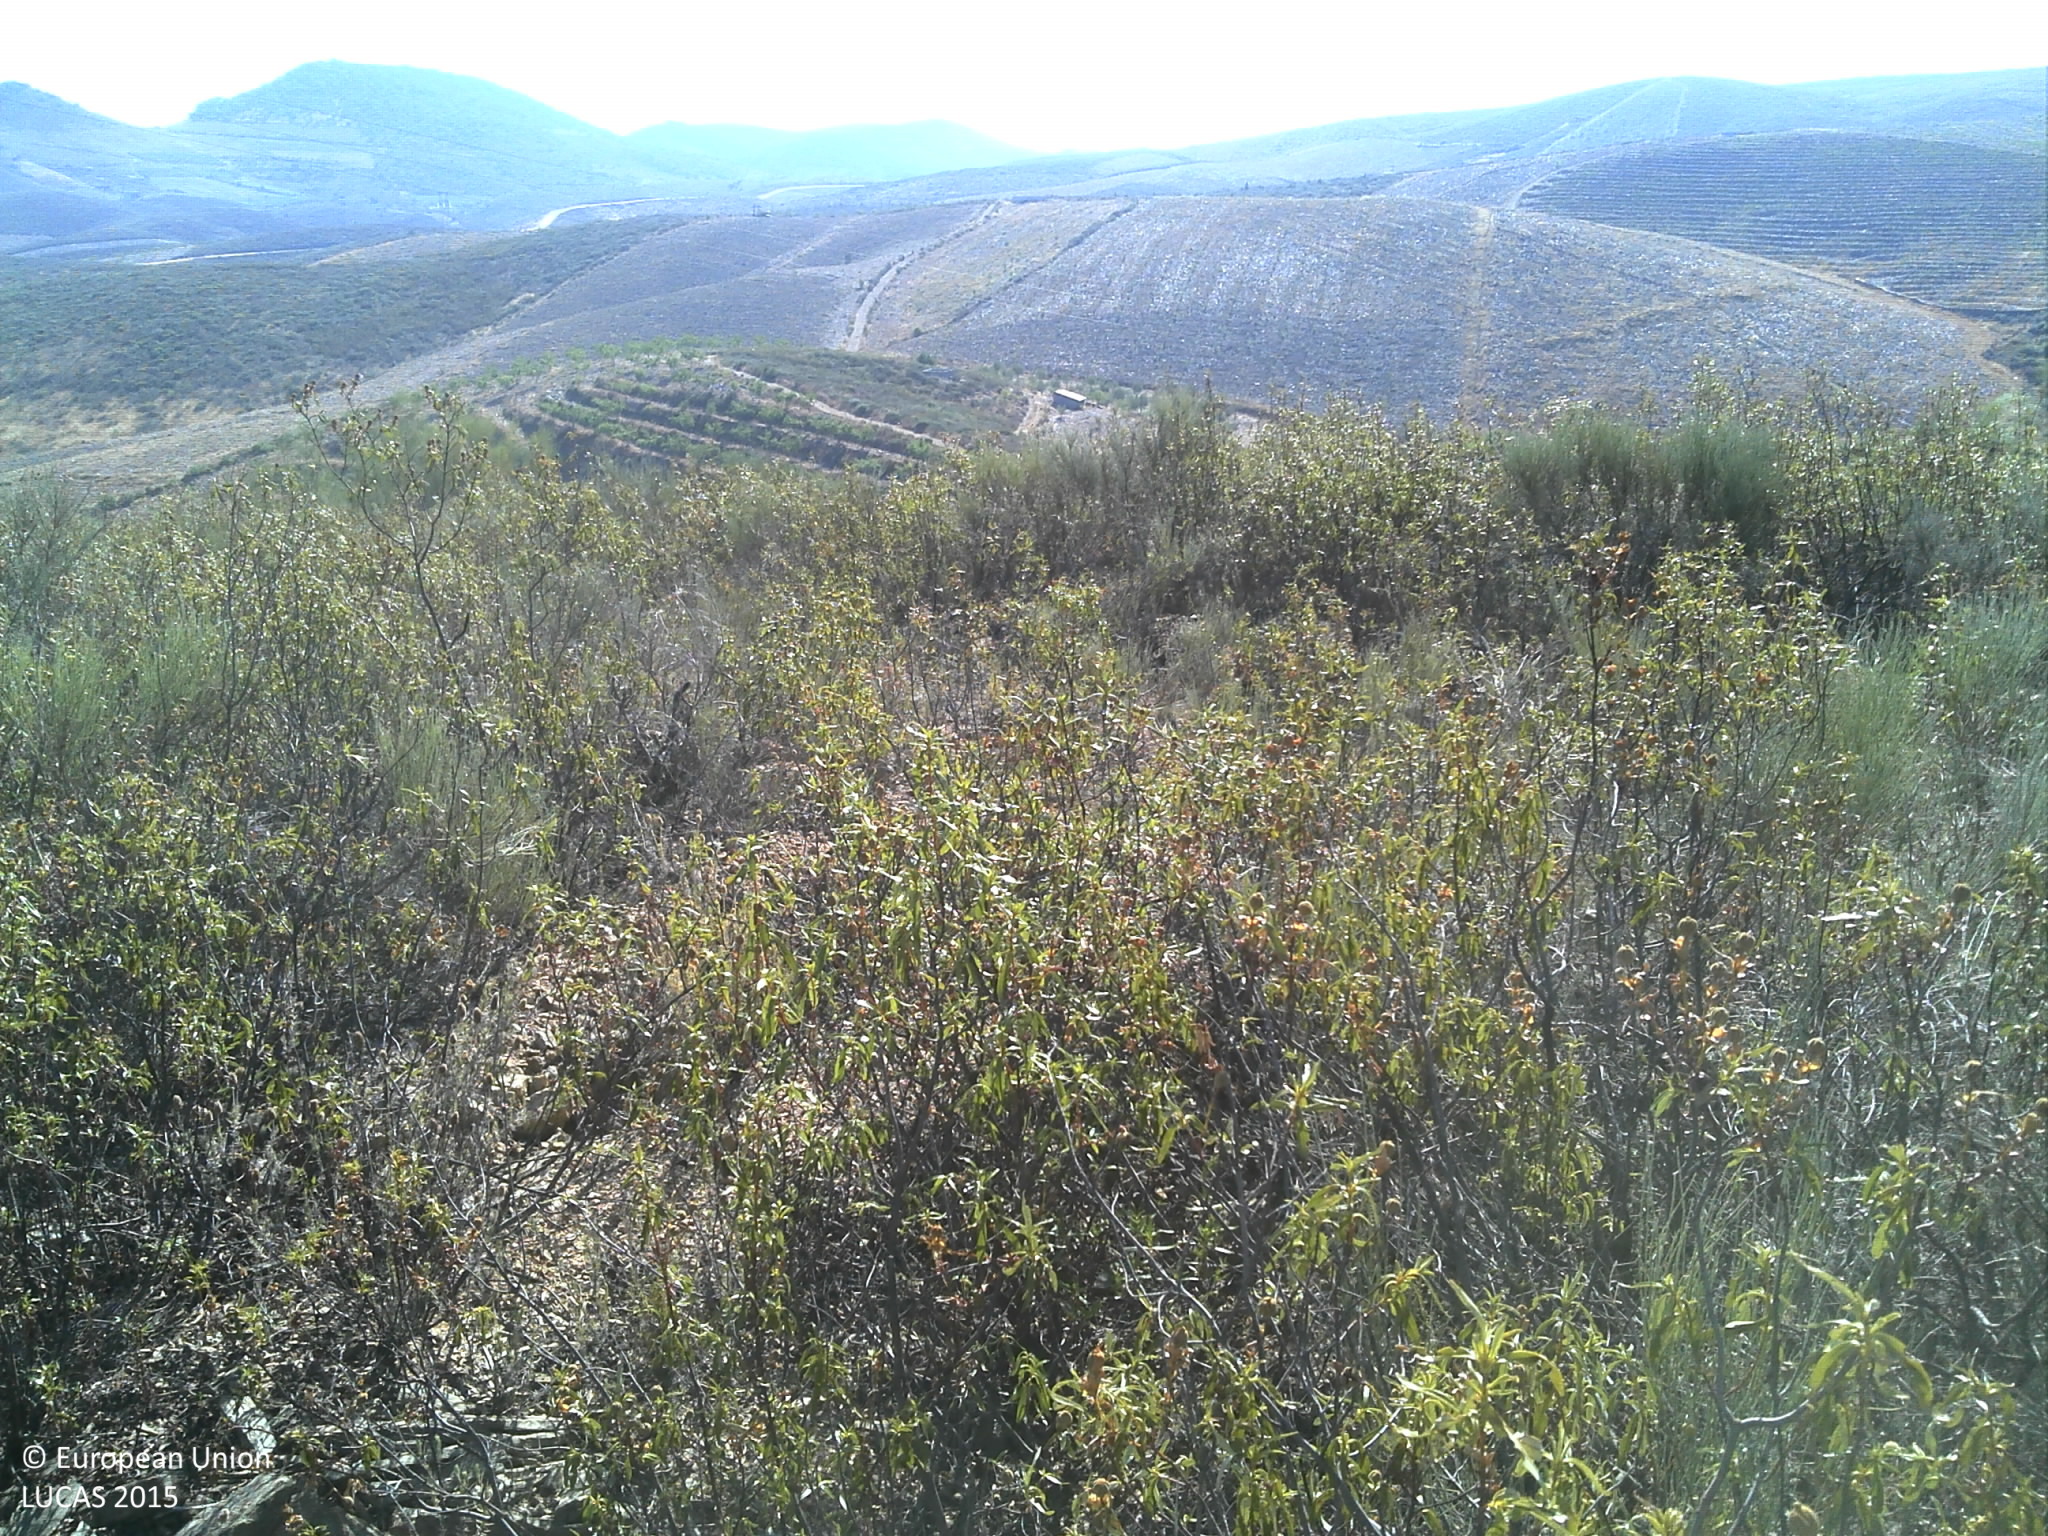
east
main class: Shrubland
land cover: Shrubland with sparse tree cover
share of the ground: > 75 %
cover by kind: shrubs 95 %, coniferous forest trees 5 %
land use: Abandoned areas
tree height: < 5 m
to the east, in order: Shrubland with sparse tree cover; Shrubland without tree cover; Dry stone walls; Shrubland without tree cover; Rock outcrops; Rivers and streams; Abandoned hedges; Shrubland without tree cover; Tracks; Shrubland without tree cover
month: July
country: PT
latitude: 41.0936
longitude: -7.0021
